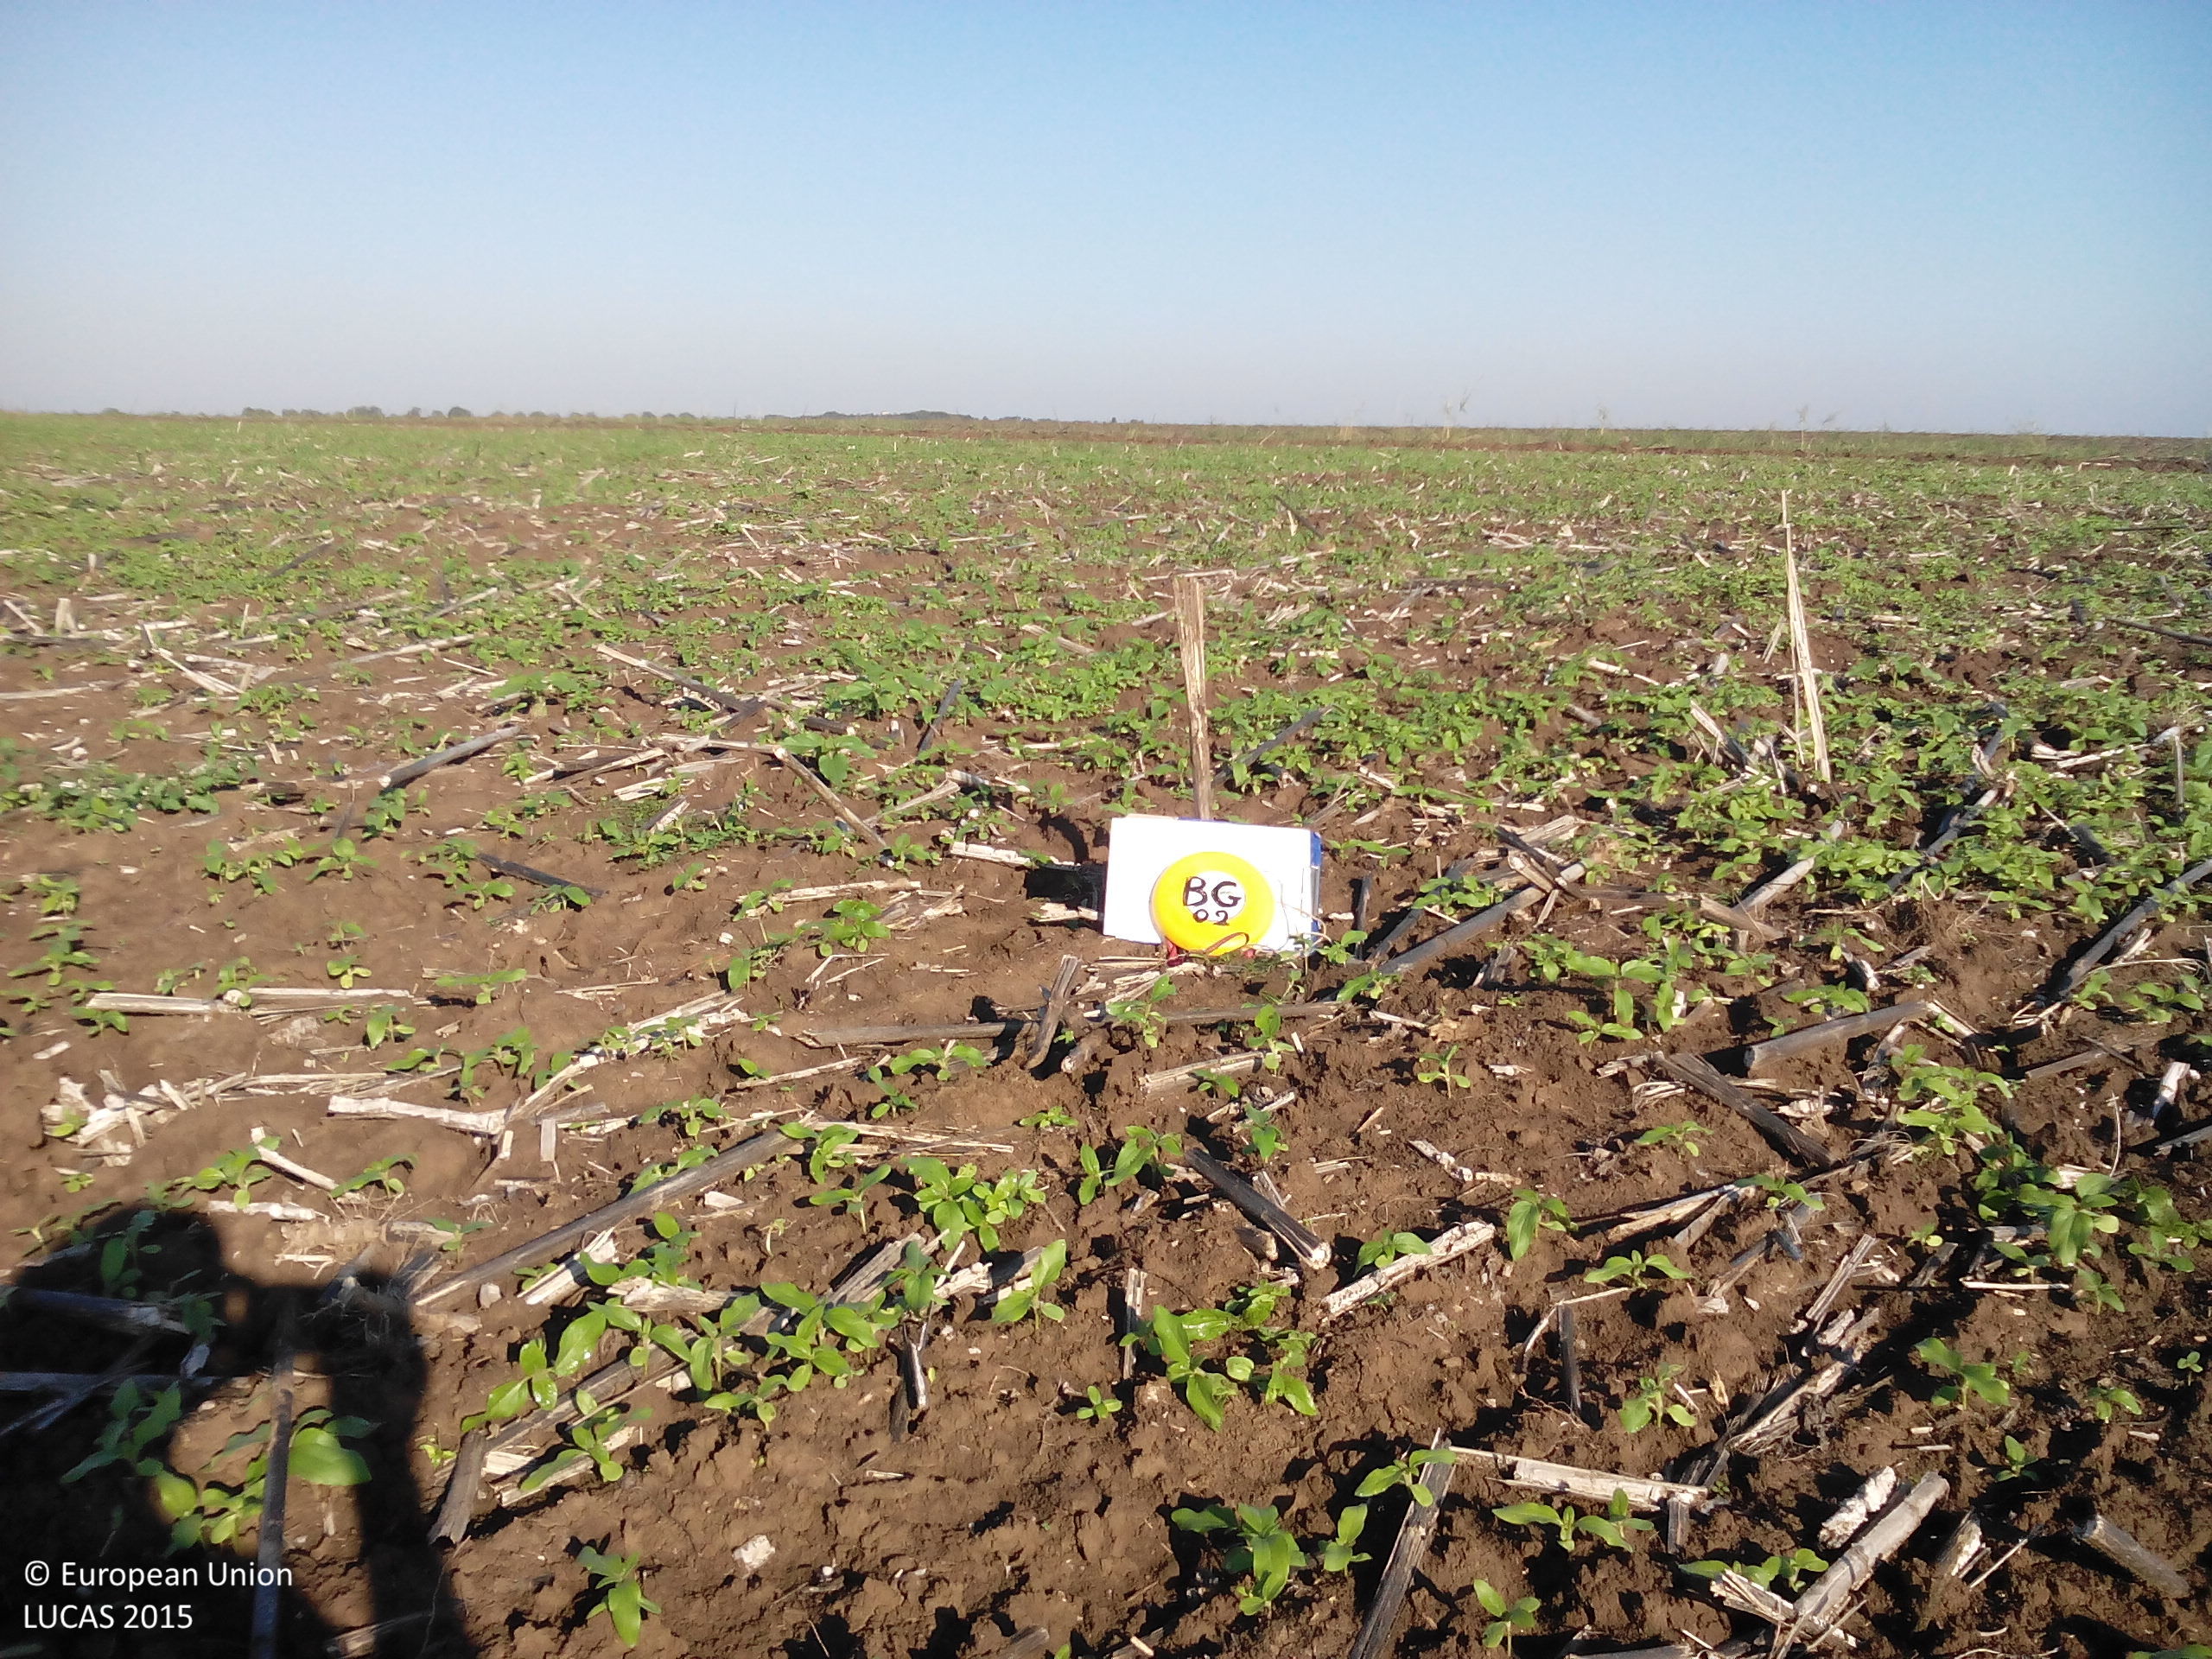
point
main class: Cropland
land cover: Sunflower
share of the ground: < 10 %
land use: Agriculture (excluding fallow land and kitchen gardens)
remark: Harvested field
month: October
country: BG
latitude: 43.4770
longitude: 23.8091
